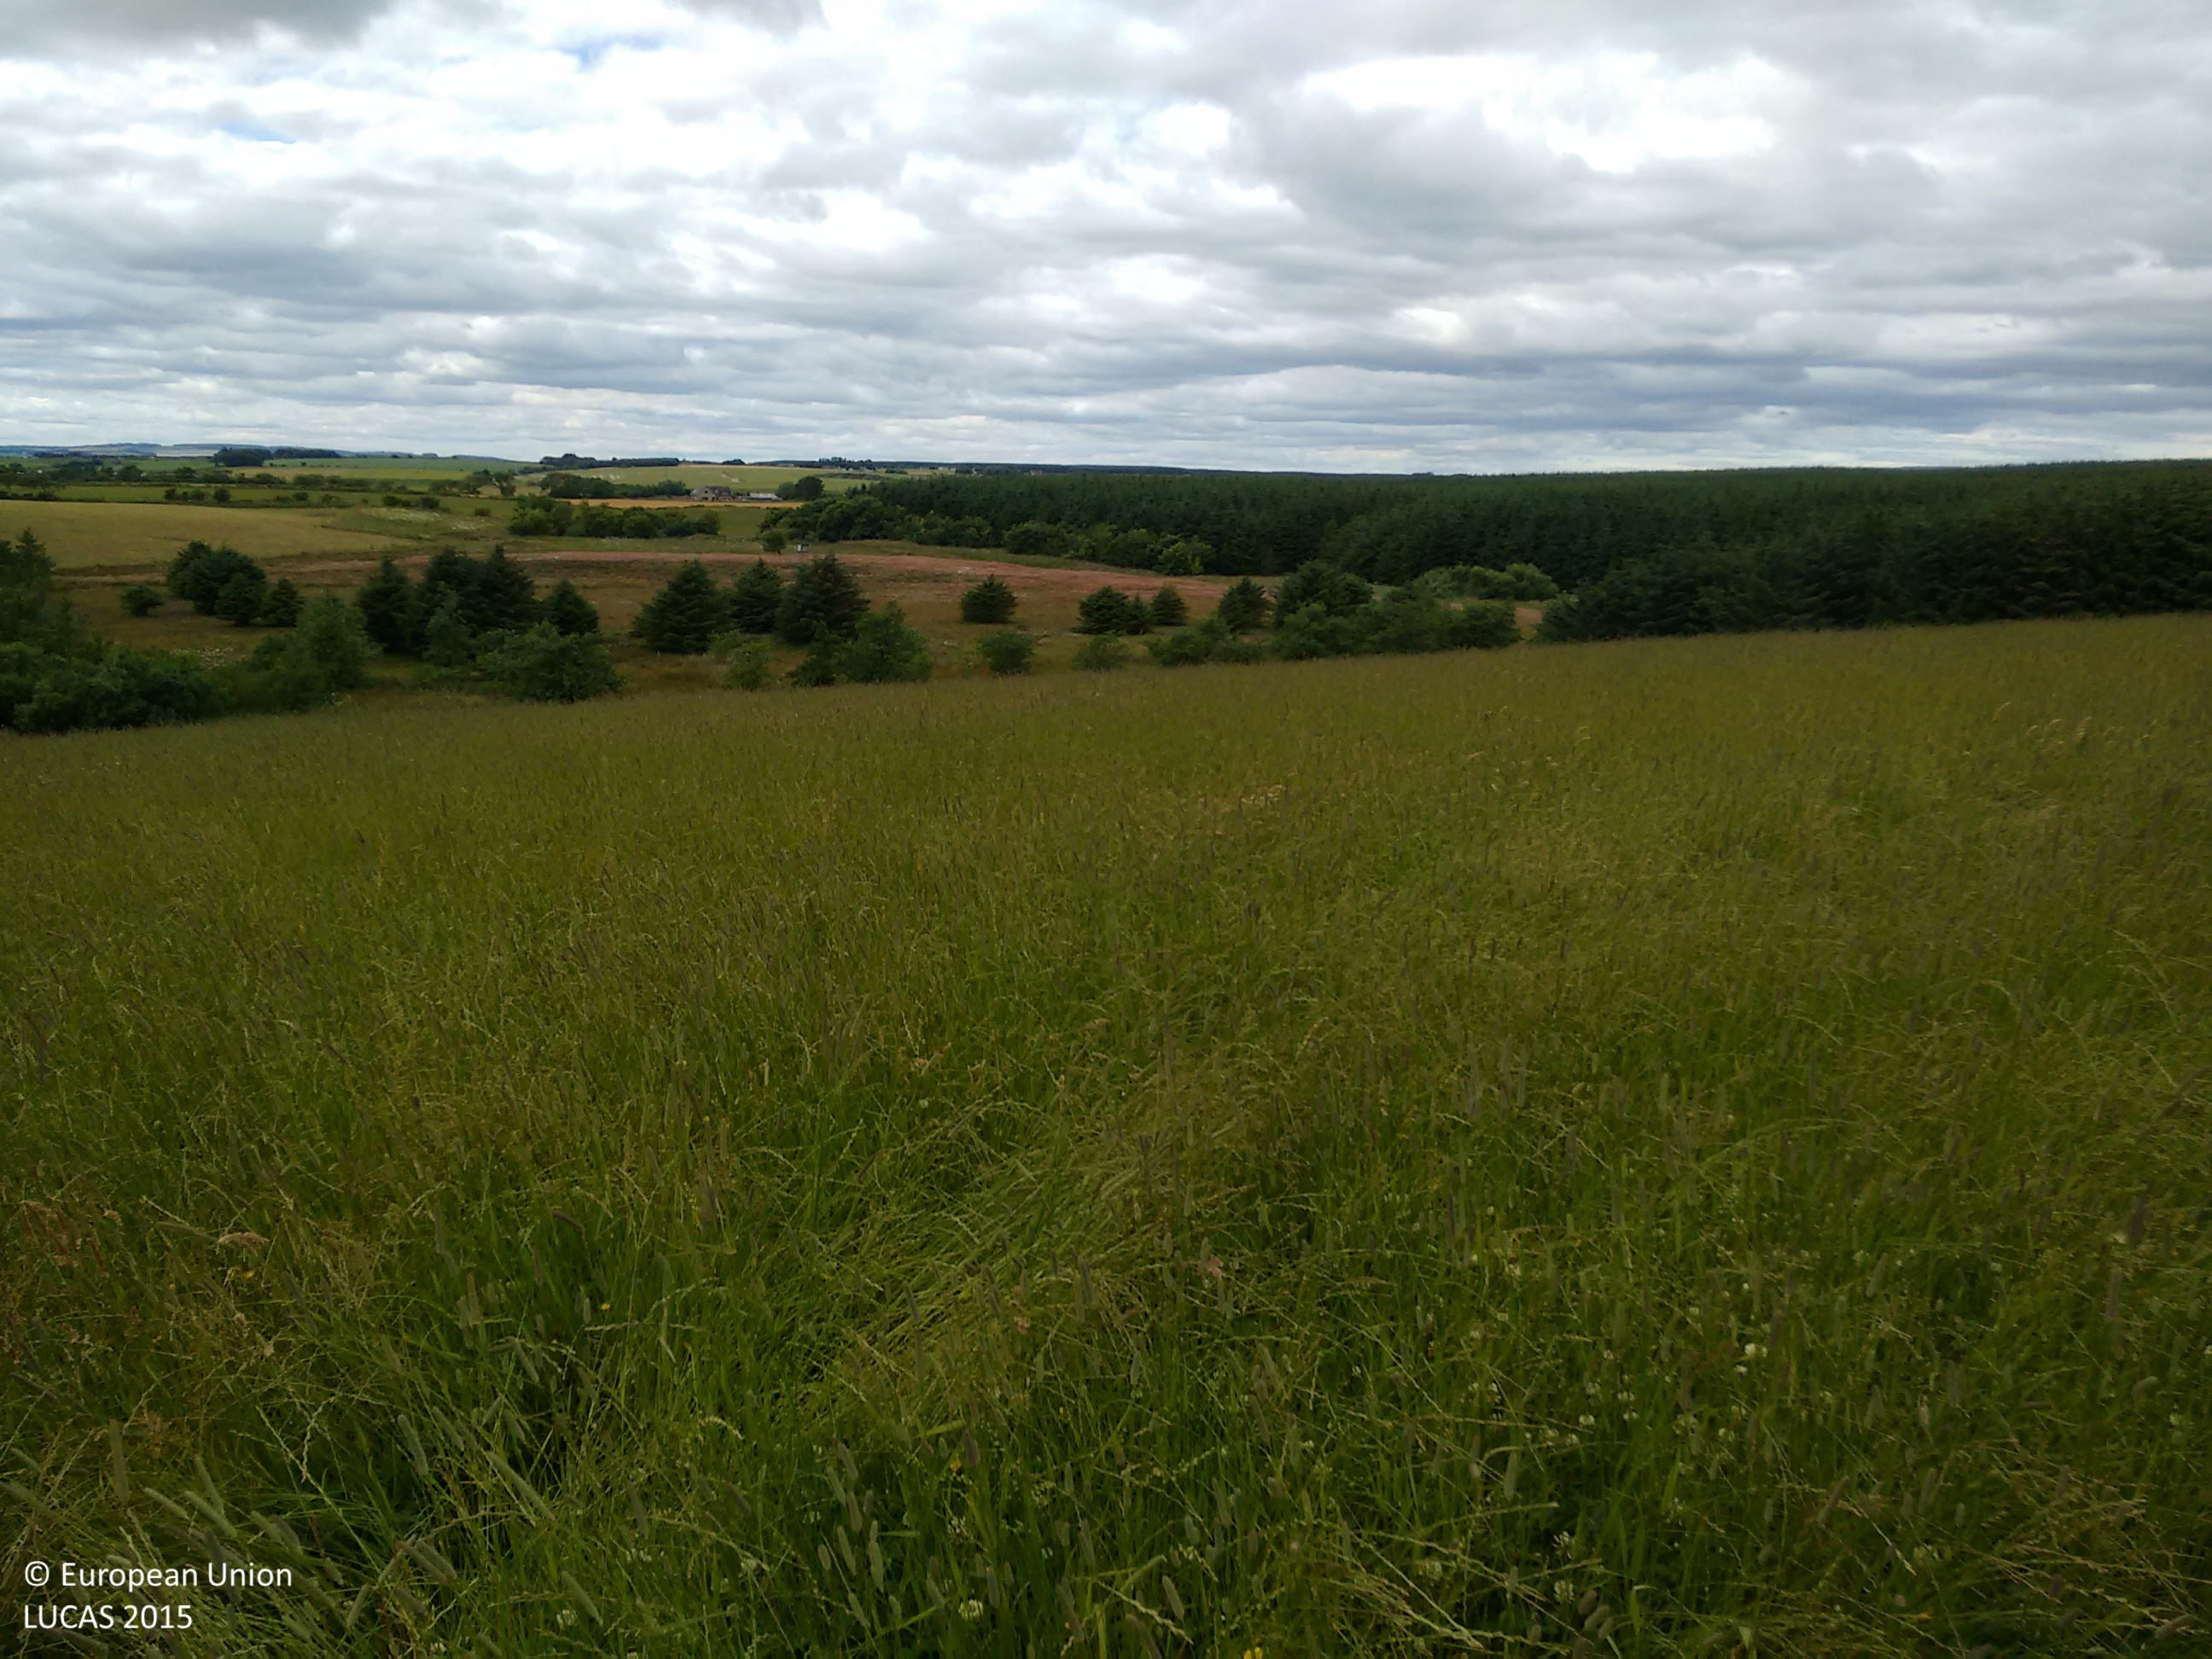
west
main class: Cropland
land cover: Temporary grasslands
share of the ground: > 75 %
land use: Agriculture (excluding fallow land and kitchen gardens)
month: July
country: GB
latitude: 57.5469
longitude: -1.8557
